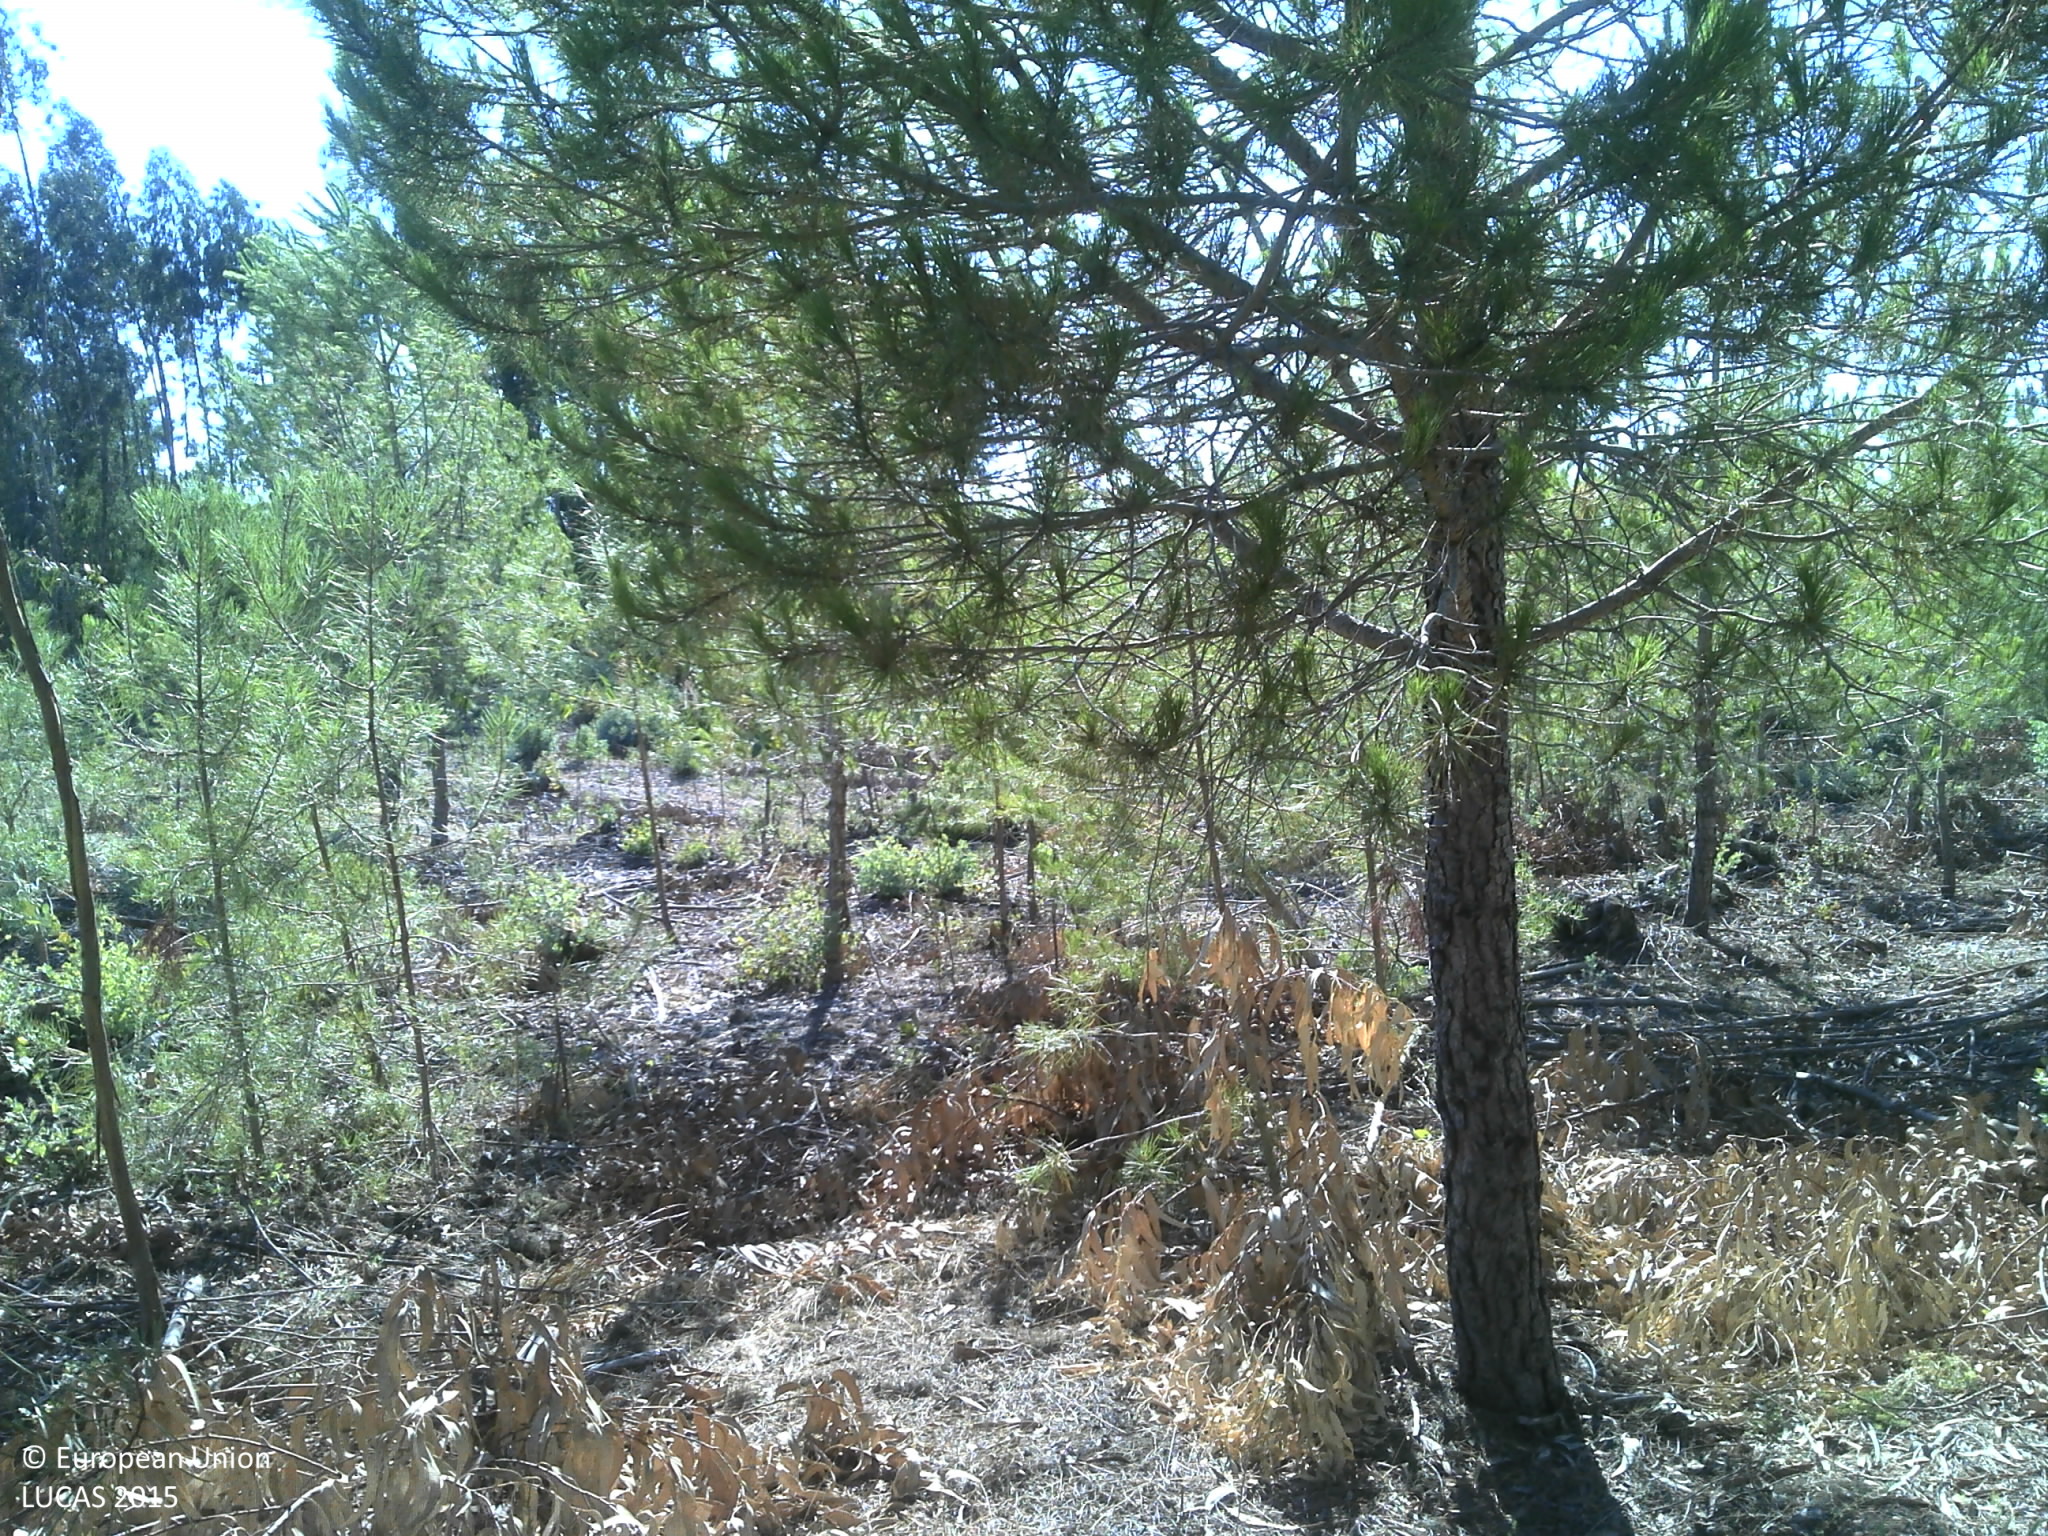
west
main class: Woodland
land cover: Pine dominated coniferous woodland
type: coniferous forest of the mediterranean region
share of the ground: 25 - 50 %
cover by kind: coniferous forest trees 50 %, unconsolidated bare surface 45 %, shrubs 5 %
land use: Forestry
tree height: < 5 m
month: July
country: PT
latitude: 39.0383
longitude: -8.6328
